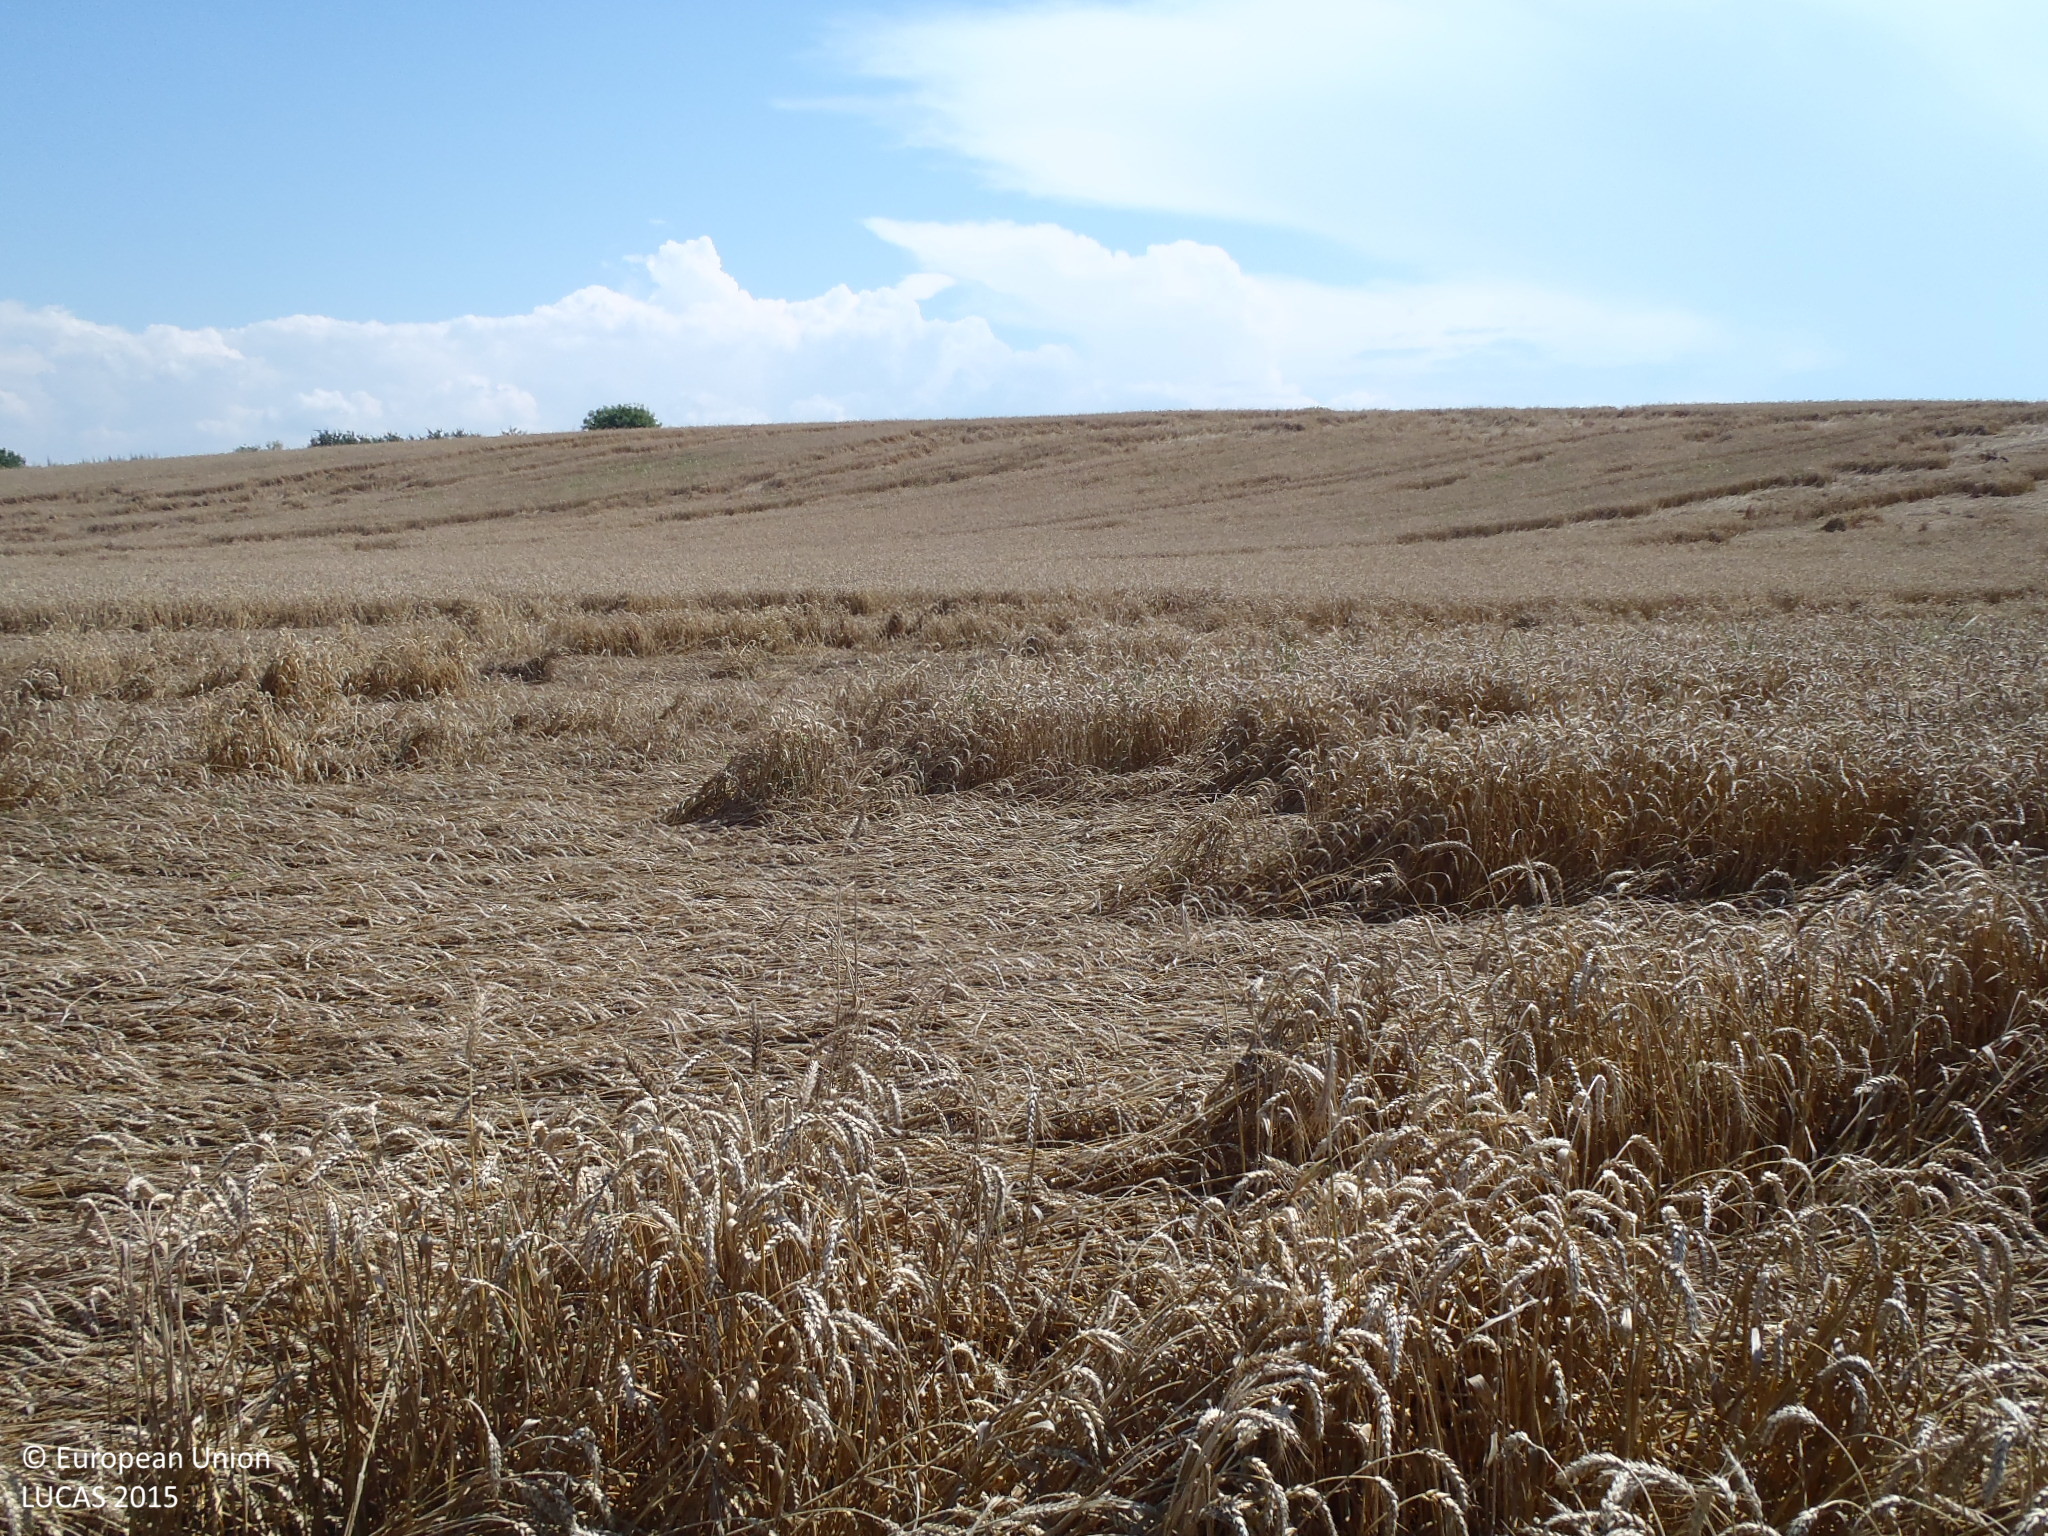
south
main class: Cropland
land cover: Common wheat
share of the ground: > 75 %
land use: Agriculture (excluding fallow land and kitchen gardens)
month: July
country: BG
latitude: 43.9665
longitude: 26.3210
